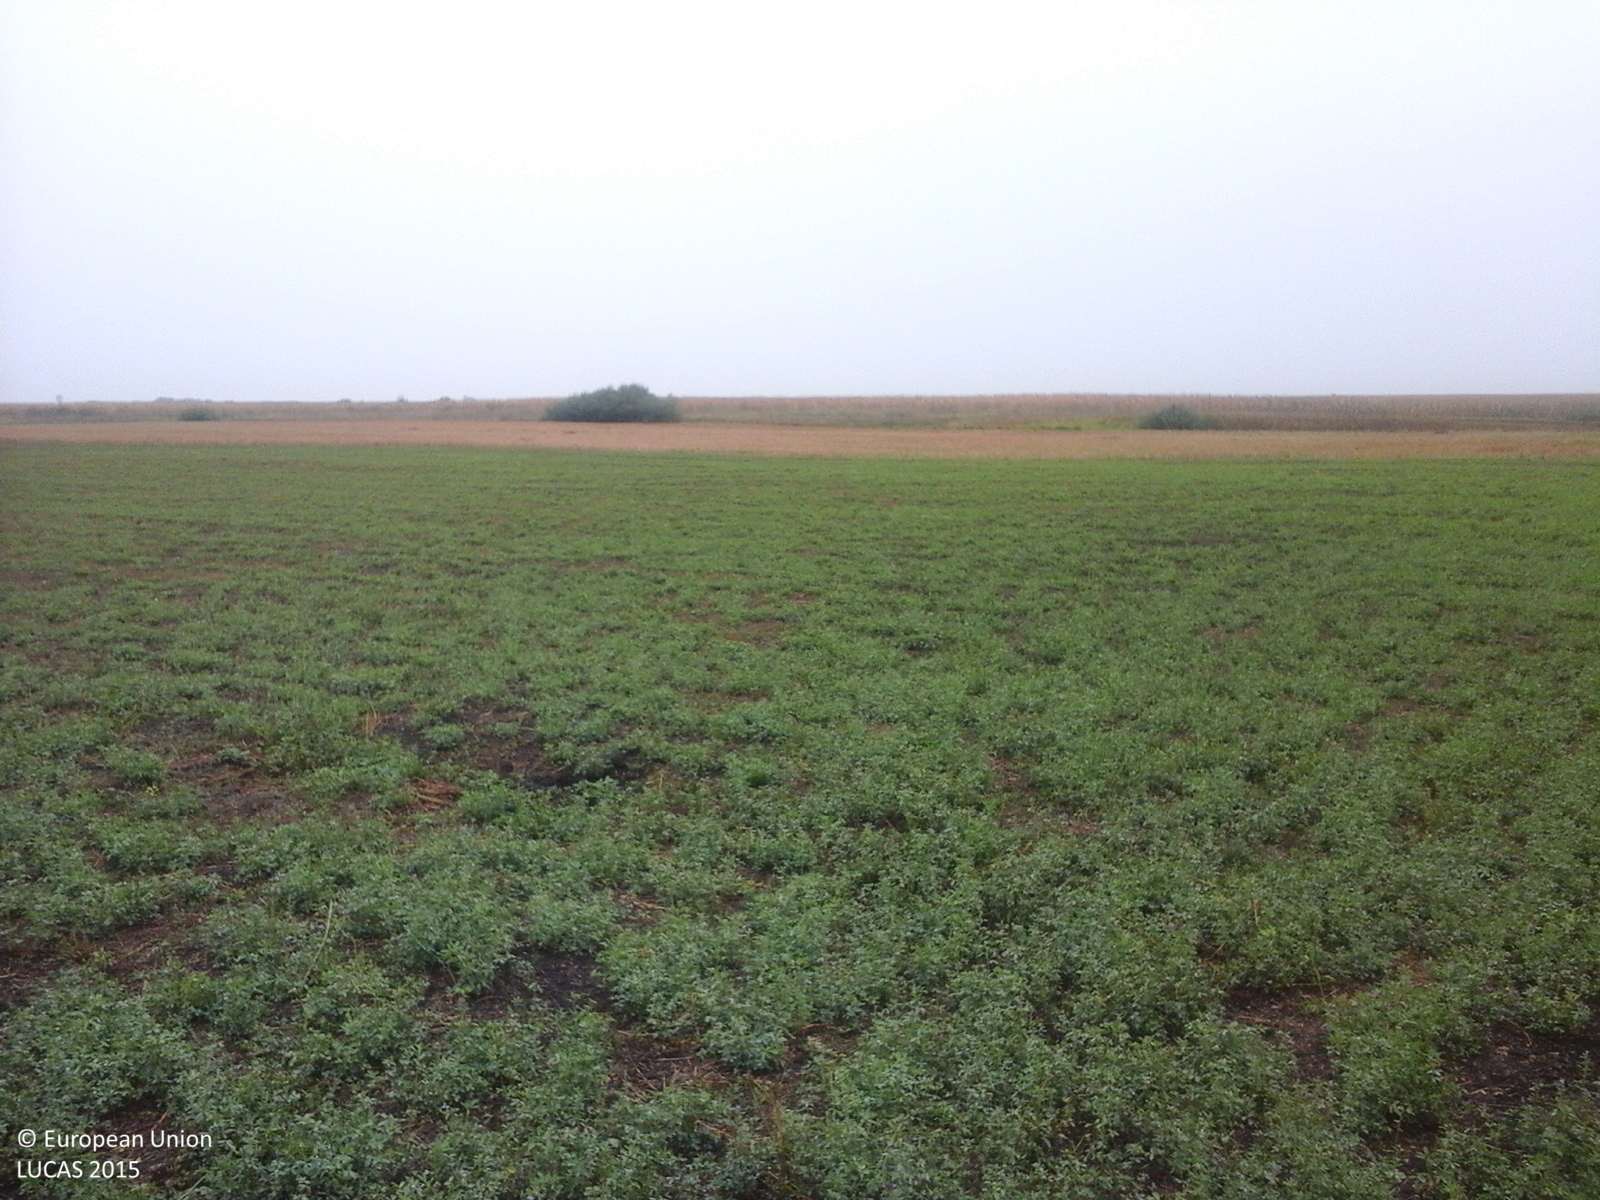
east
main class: Cropland
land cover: Soya
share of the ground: > 75 %
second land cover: Spontaneously vegetated surfaces
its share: > 75 %
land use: Agriculture (excluding fallow land and kitchen gardens)
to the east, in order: Soya; Spontaneously vegetated surfaces; Lucerne; Common wheat; Grass margins; Ditches and canals; Grass margins; Tracks; Grass margins; Ditches and canals; Grass margins; Maize
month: September
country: RO
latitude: 47.7806
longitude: 22.5107
